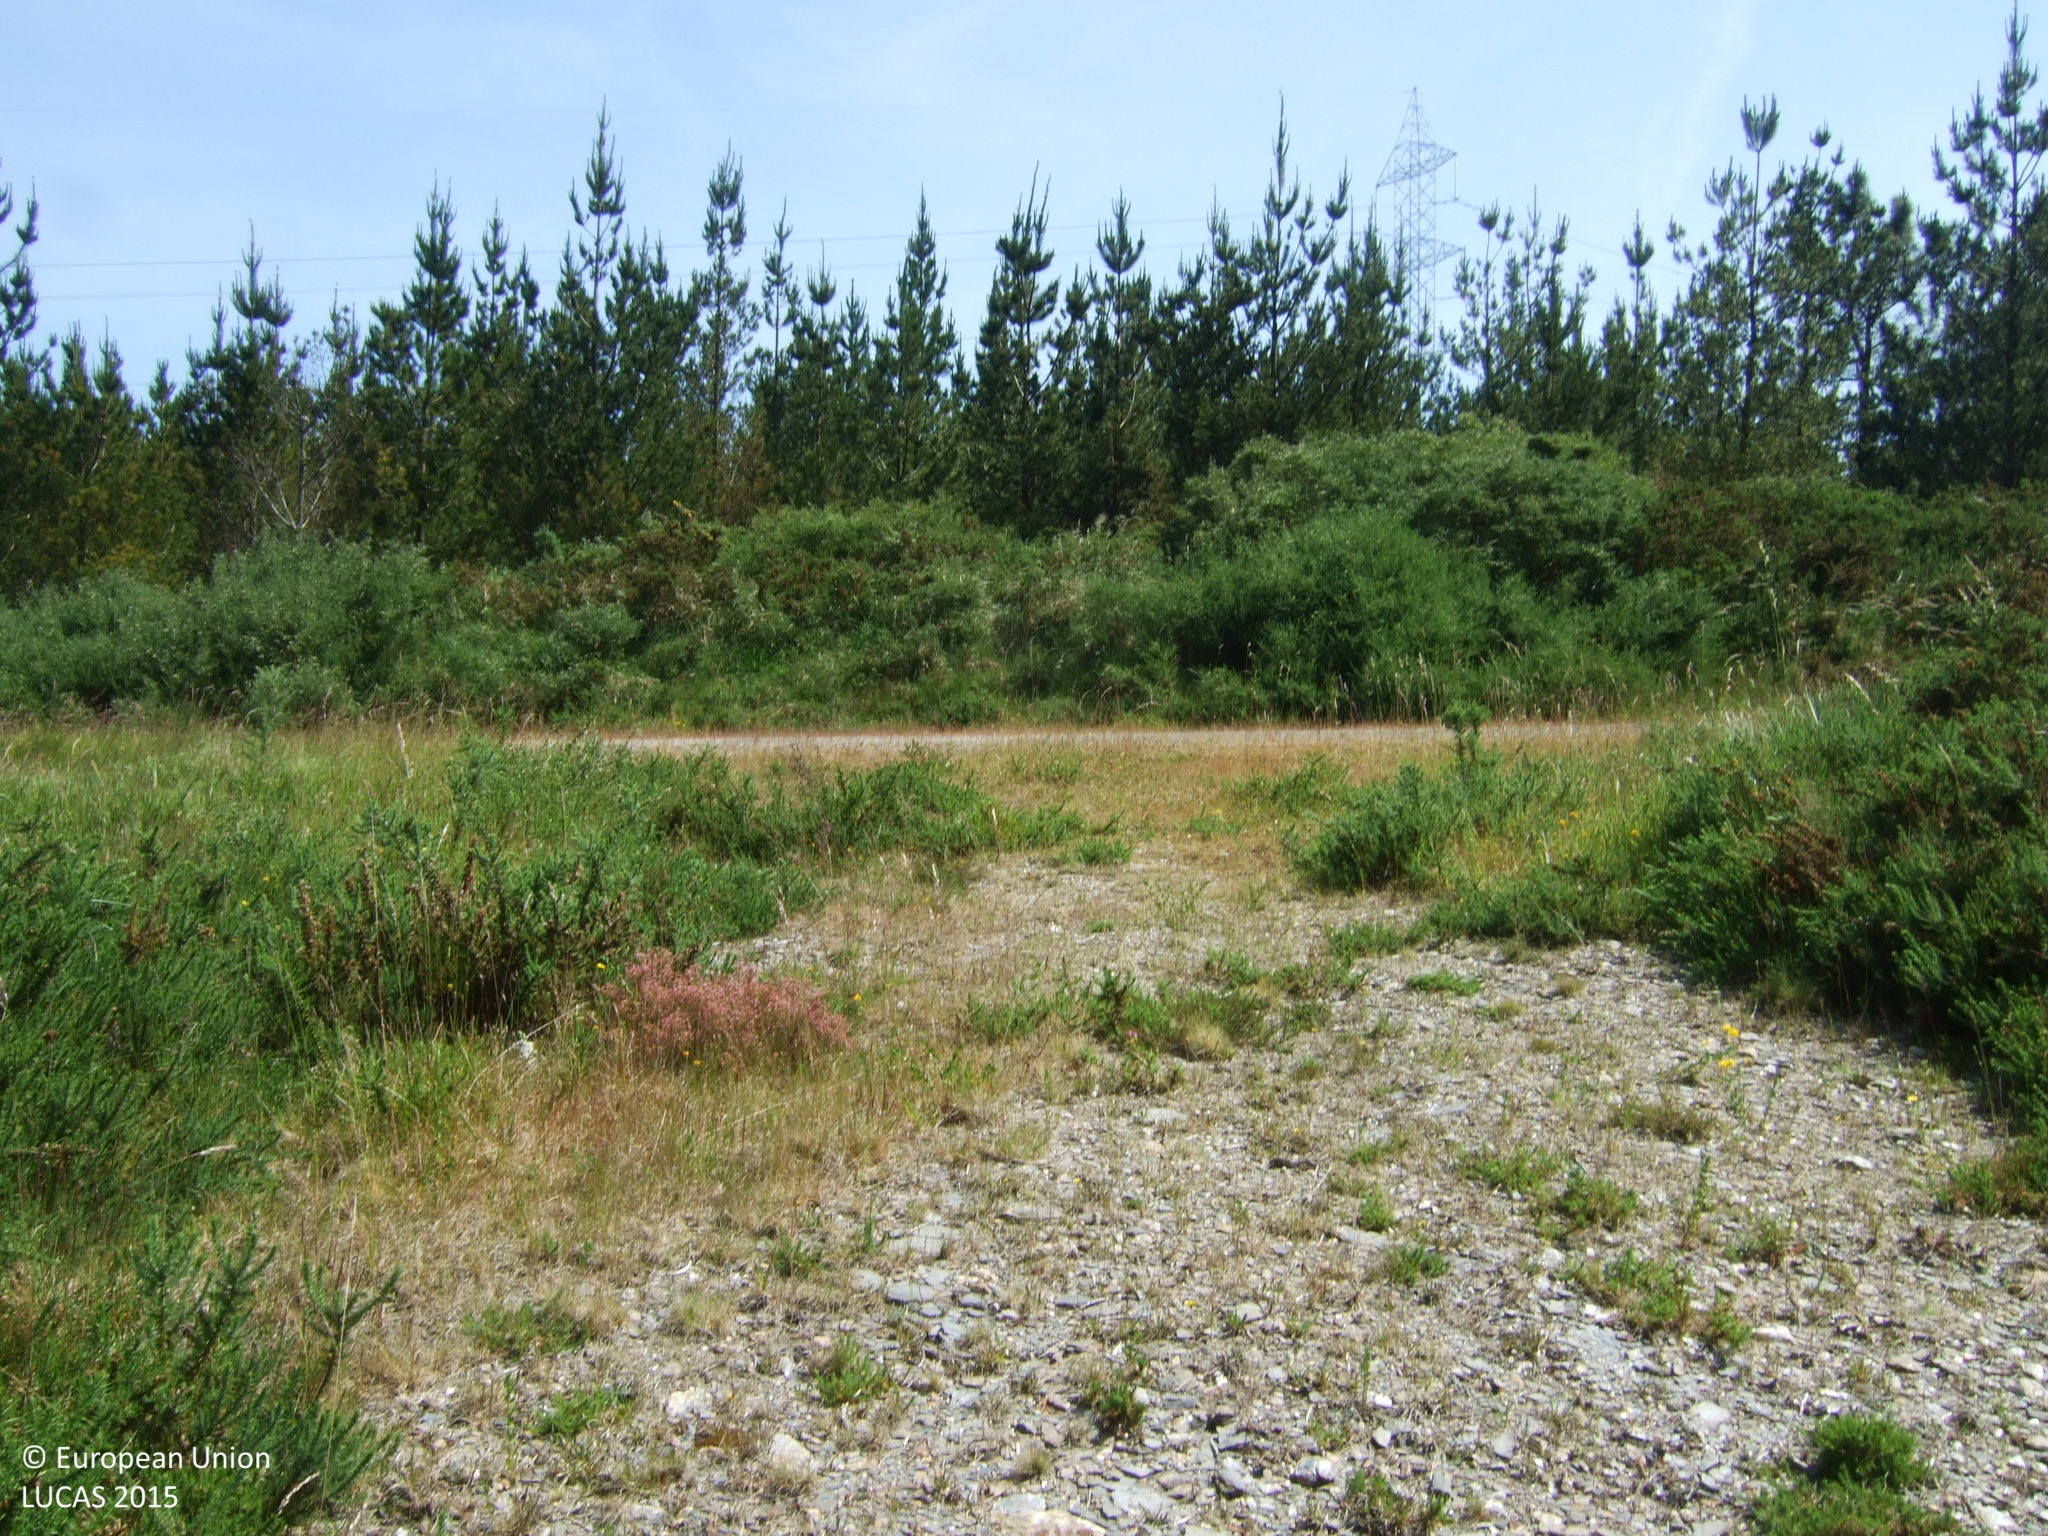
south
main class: Woodland
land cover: Pine dominated coniferous woodland
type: exotic forest
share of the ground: 50 - 75 %
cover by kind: coniferous forest trees 70 %, shrubs 30 %
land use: Forestry
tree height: < 5 m
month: June
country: ES
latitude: 43.4425
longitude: -7.7951
